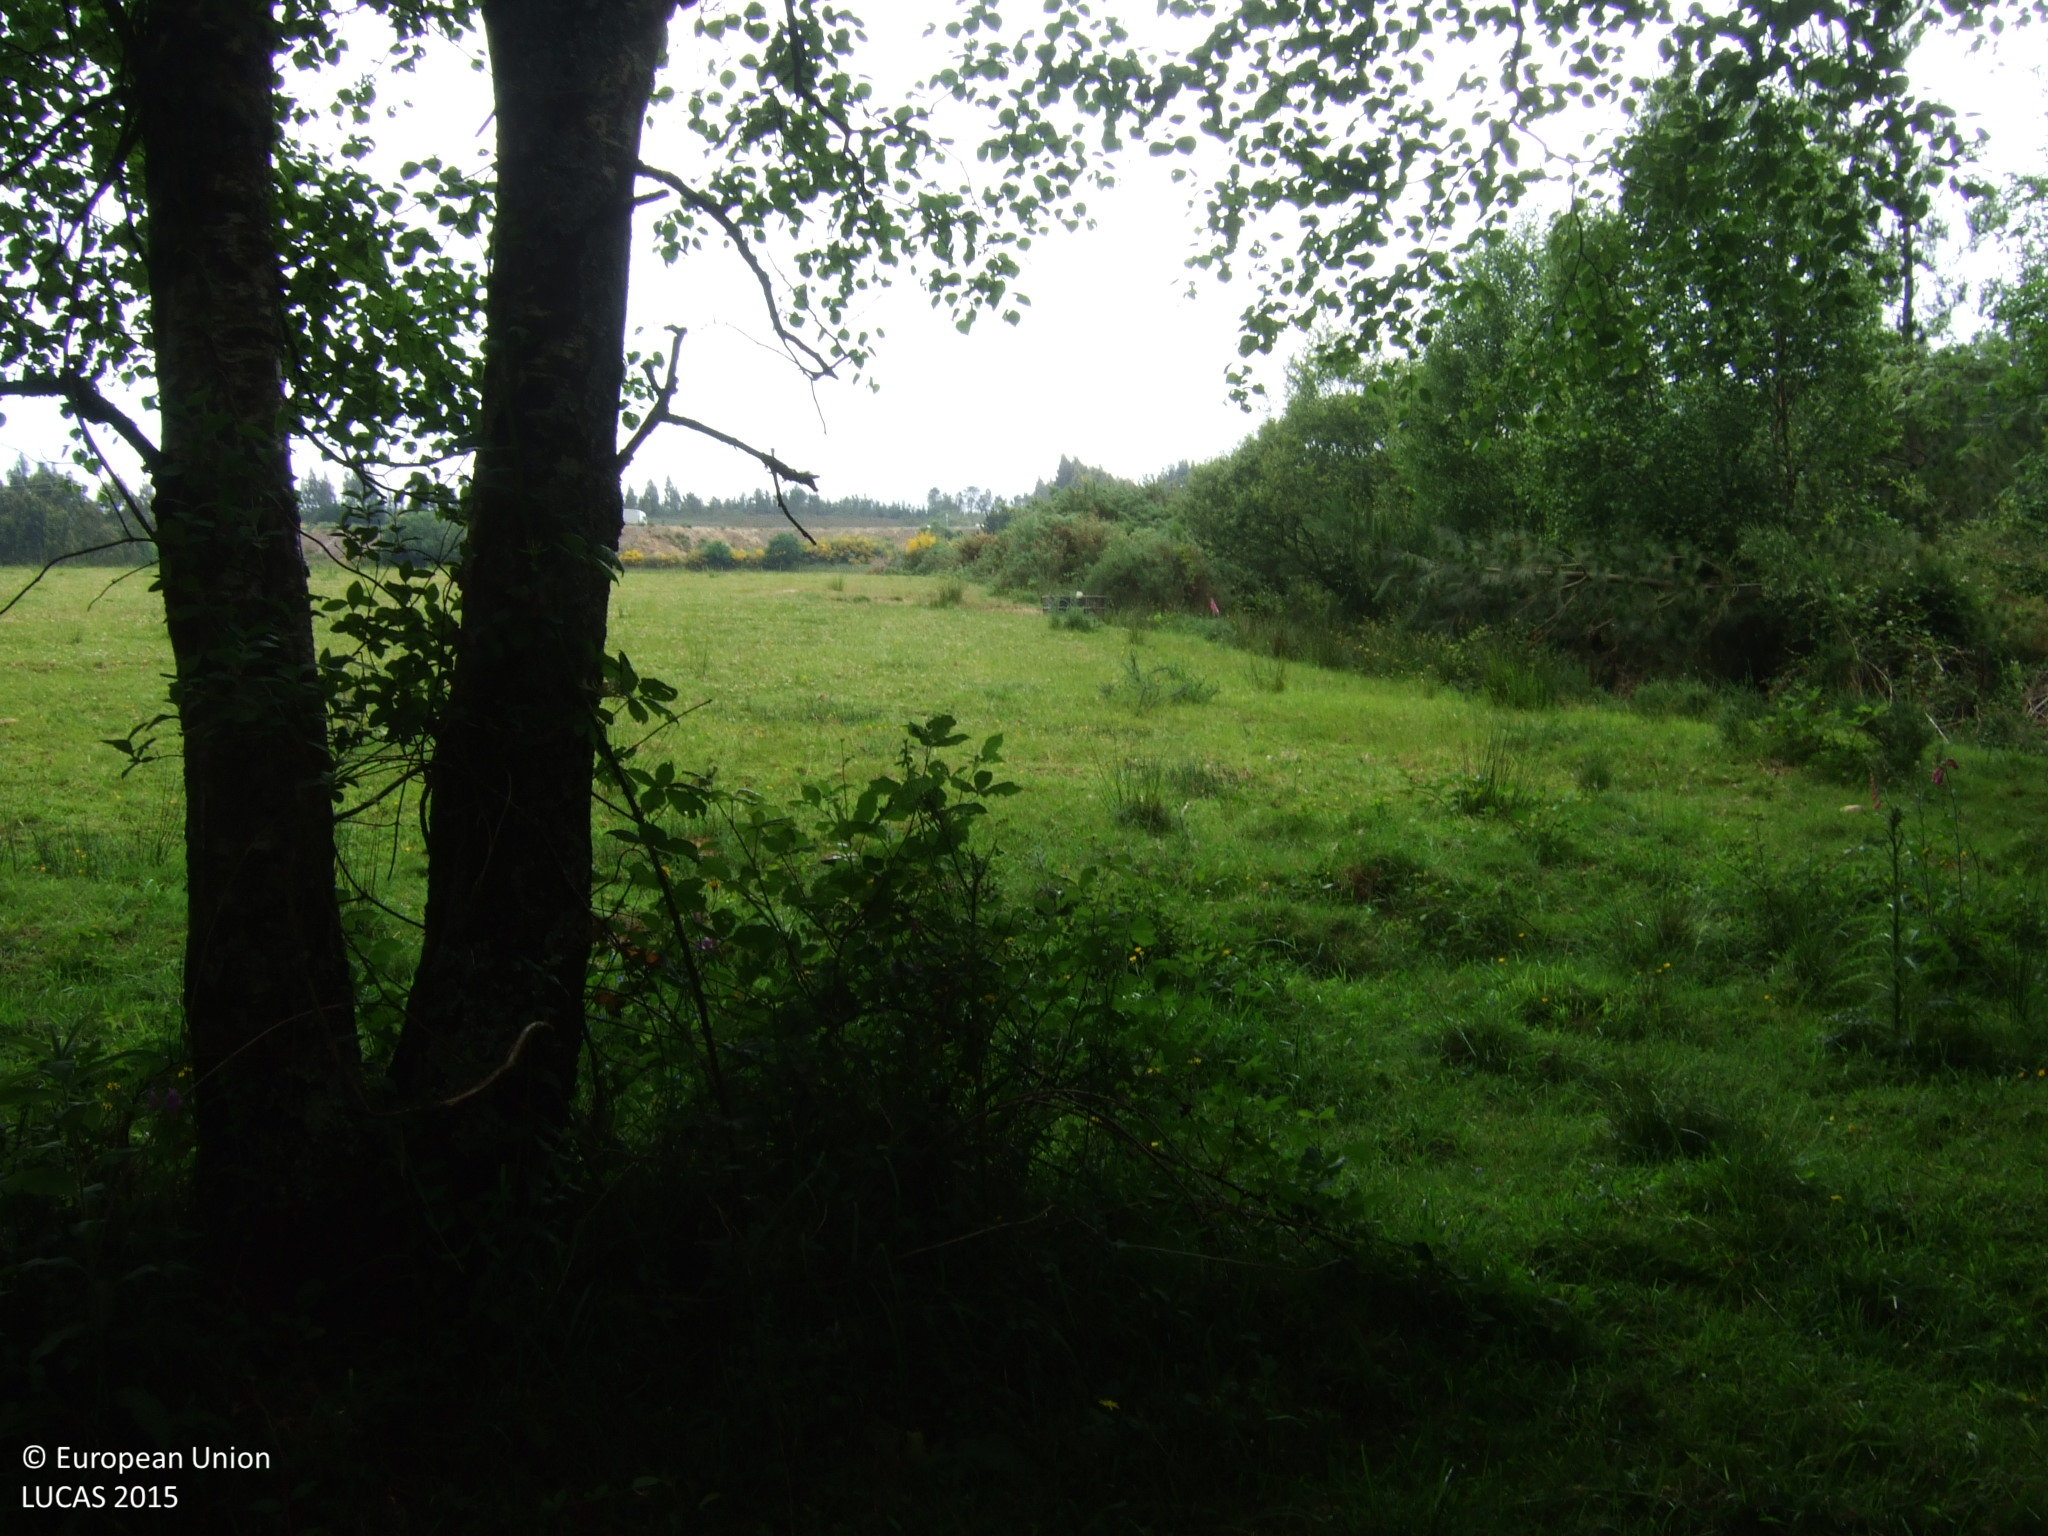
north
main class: Woodland
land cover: Broadleaved woodland
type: floodplain forest
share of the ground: 50 - 75 %
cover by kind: broadleaved forest trees 70 %, herbaceous plants 20 %, shrubs 10 %
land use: Semi-natural and natural areas not in use
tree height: > 5 m
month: June
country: ES
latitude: 43.4033
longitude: -7.8083
